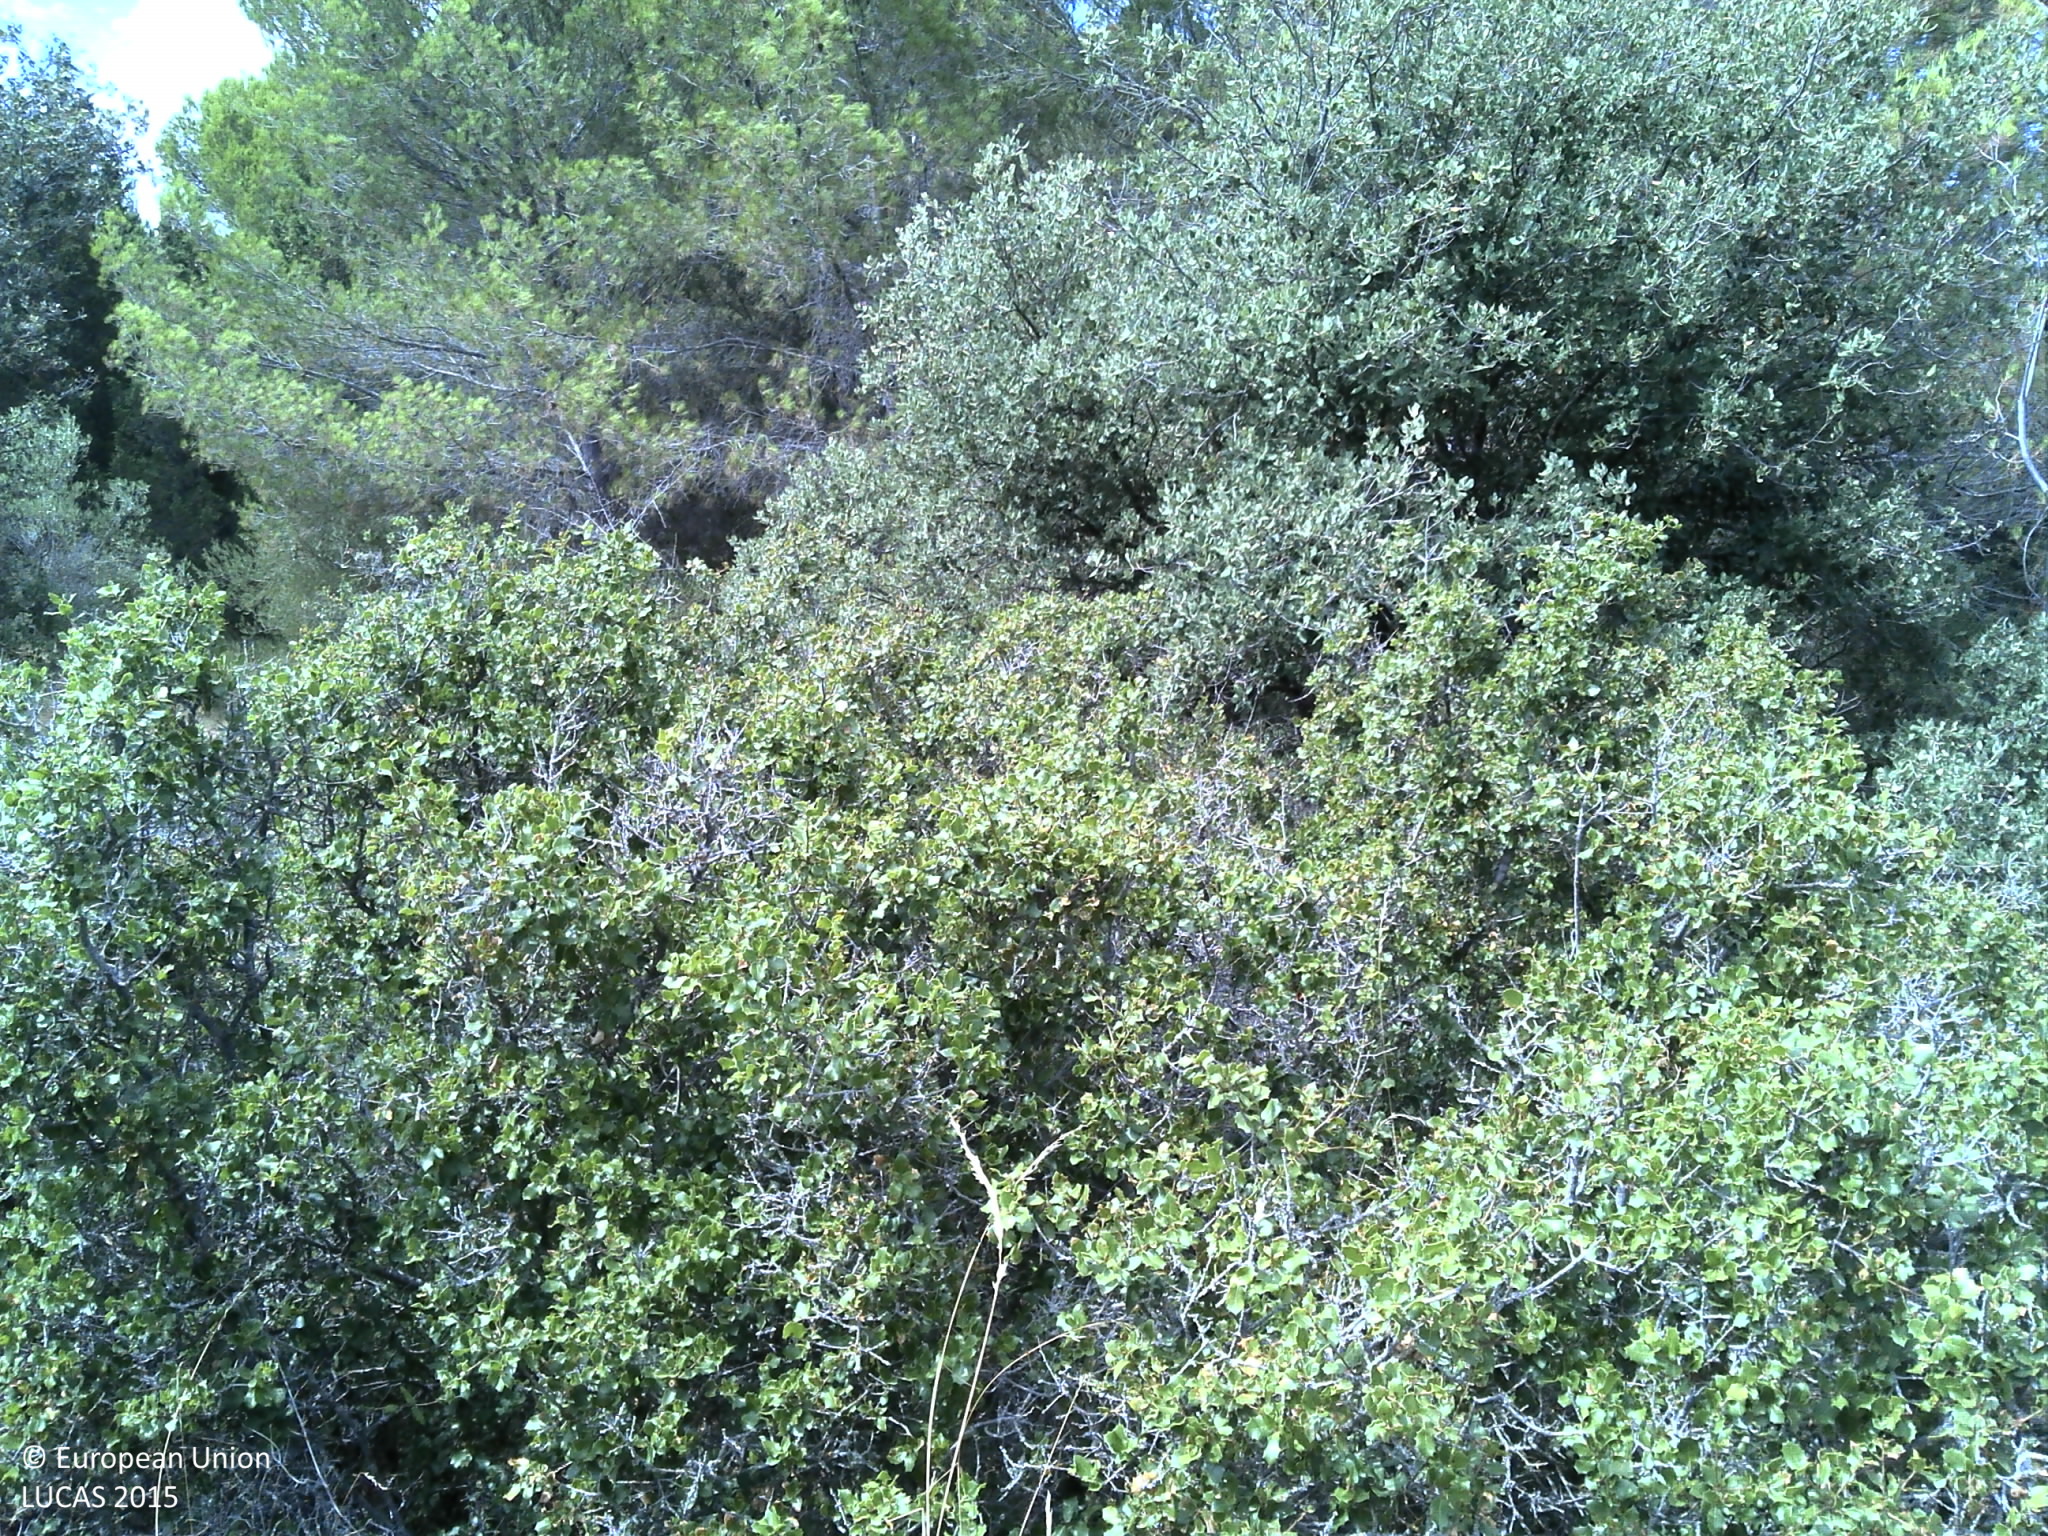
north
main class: Woodland
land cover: Broadleaved woodland
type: broadleaved evergreen forest
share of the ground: > 75 %
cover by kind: broadleaved forest trees 55 %, coniferous forest trees 15 %, shrubs 15 %, herbaceous plants 5 %, consolidated bare surface 5 %, unconsolidated bare surface 5 %
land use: Semi-natural and natural areas not in use
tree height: > 5 m
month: July
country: FR
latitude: 43.4666
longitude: 3.6190
